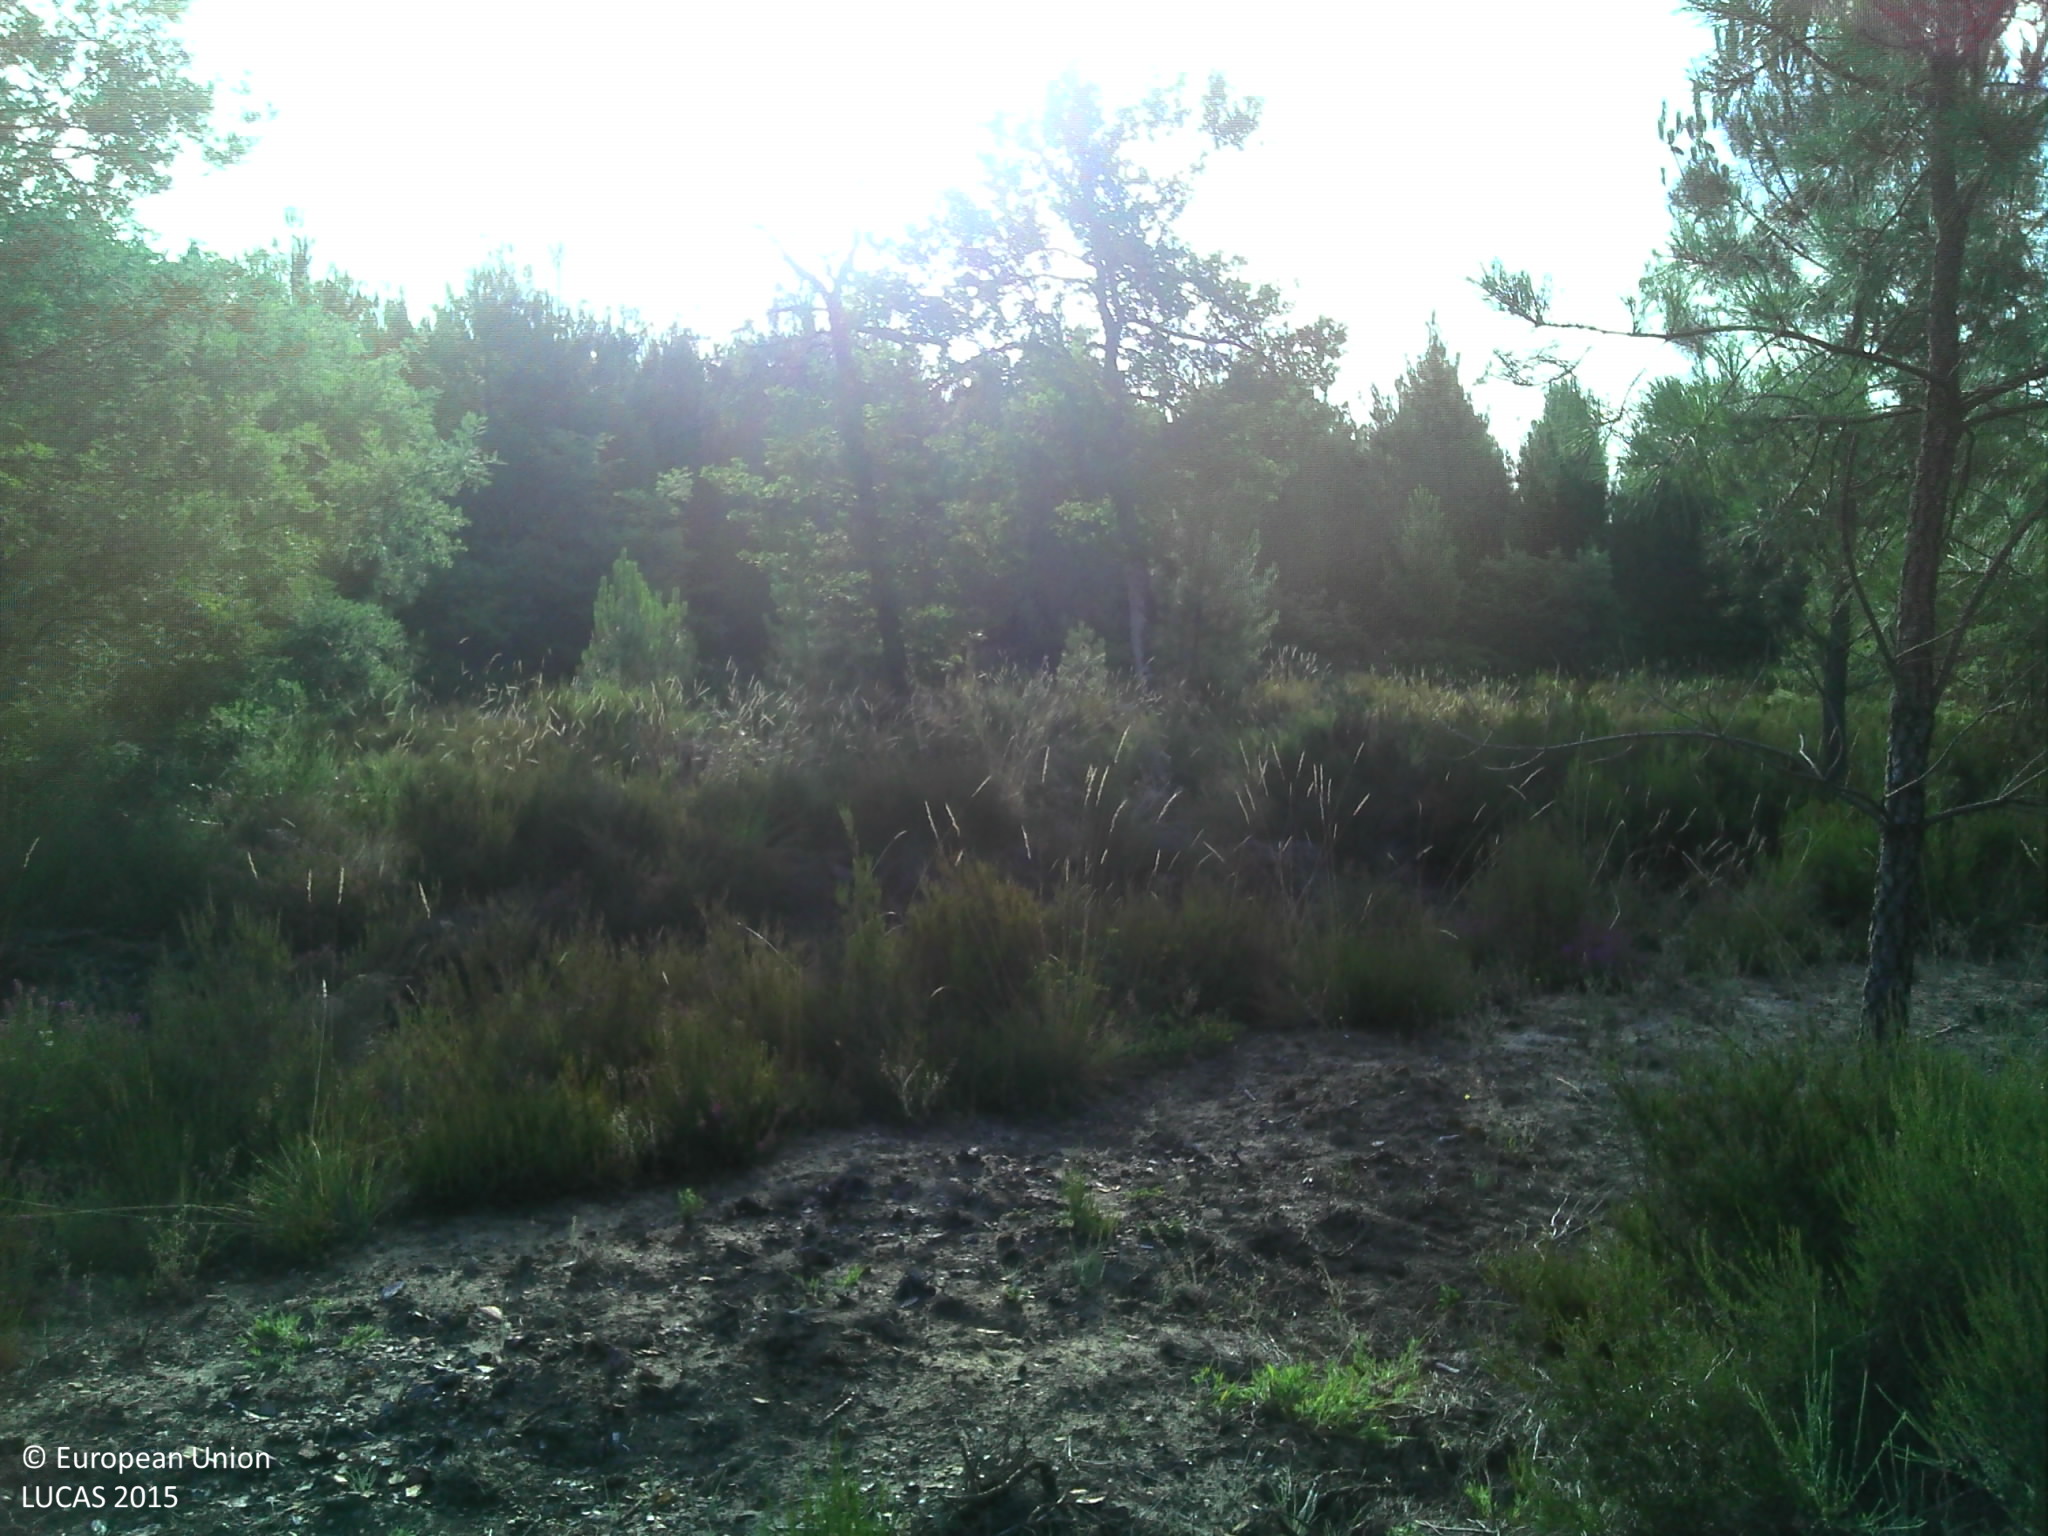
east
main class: Woodland
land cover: Pine dominated coniferous woodland
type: coniferous forest of the mediterranean region
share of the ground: 50 - 75 %
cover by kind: coniferous forest trees 70 %, herbaceous plants 20 %, broadleaved forest trees 10 %
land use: Forestry
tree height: < 5 m
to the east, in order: Pine dominated coniferous woodland; Ditches and canals; Spontaneously vegetated surfaces; Ditches and canals; Grass margins; Paved roads, cycling and walking lanes; Grass margins; Ditches and canals; Spontaneously vegetated surfaces; Pine dominated coniferous woodland
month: July
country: FR
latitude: 44.0644
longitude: -0.5629
